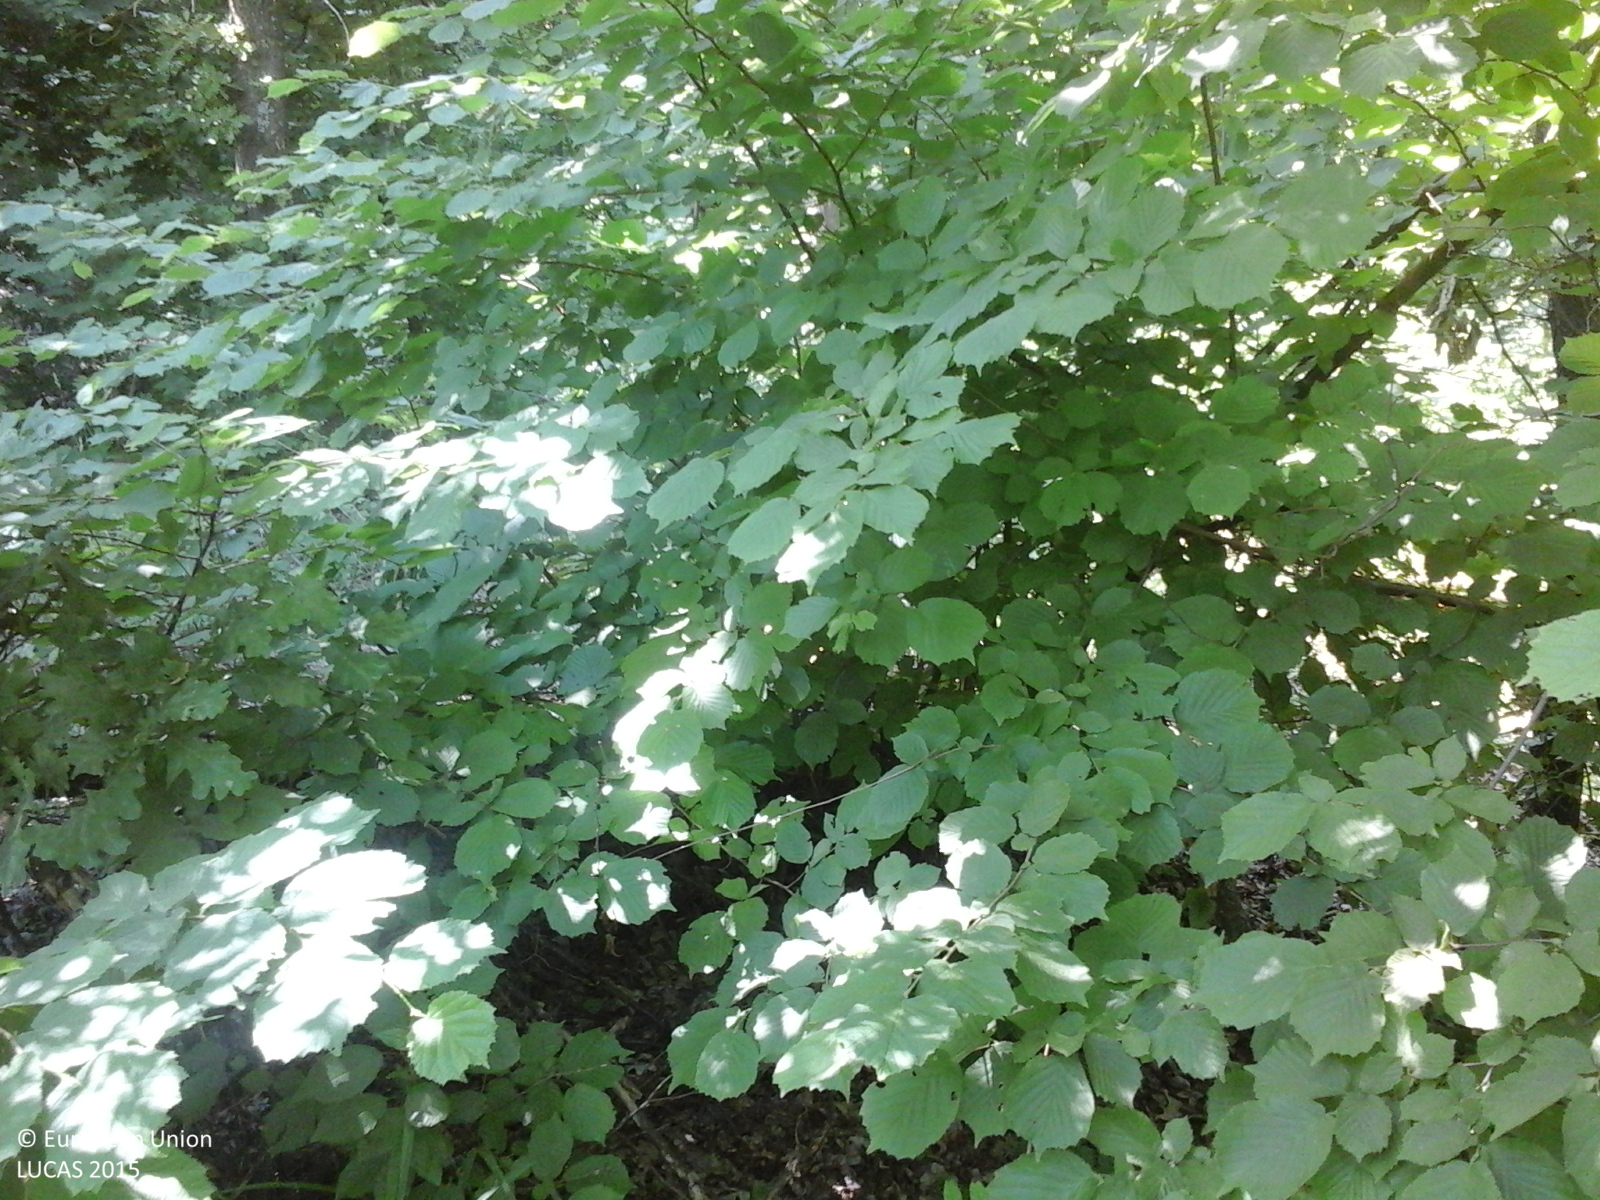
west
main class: Woodland
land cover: Broadleaved woodland
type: beech forest
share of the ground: > 75 %
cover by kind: broadleaved forest trees 85 %, herbaceous plants 10 %, shrubs 5 %
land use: Forestry
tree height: > 5 m
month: June
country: RO
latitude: 46.7415
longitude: 27.2372
